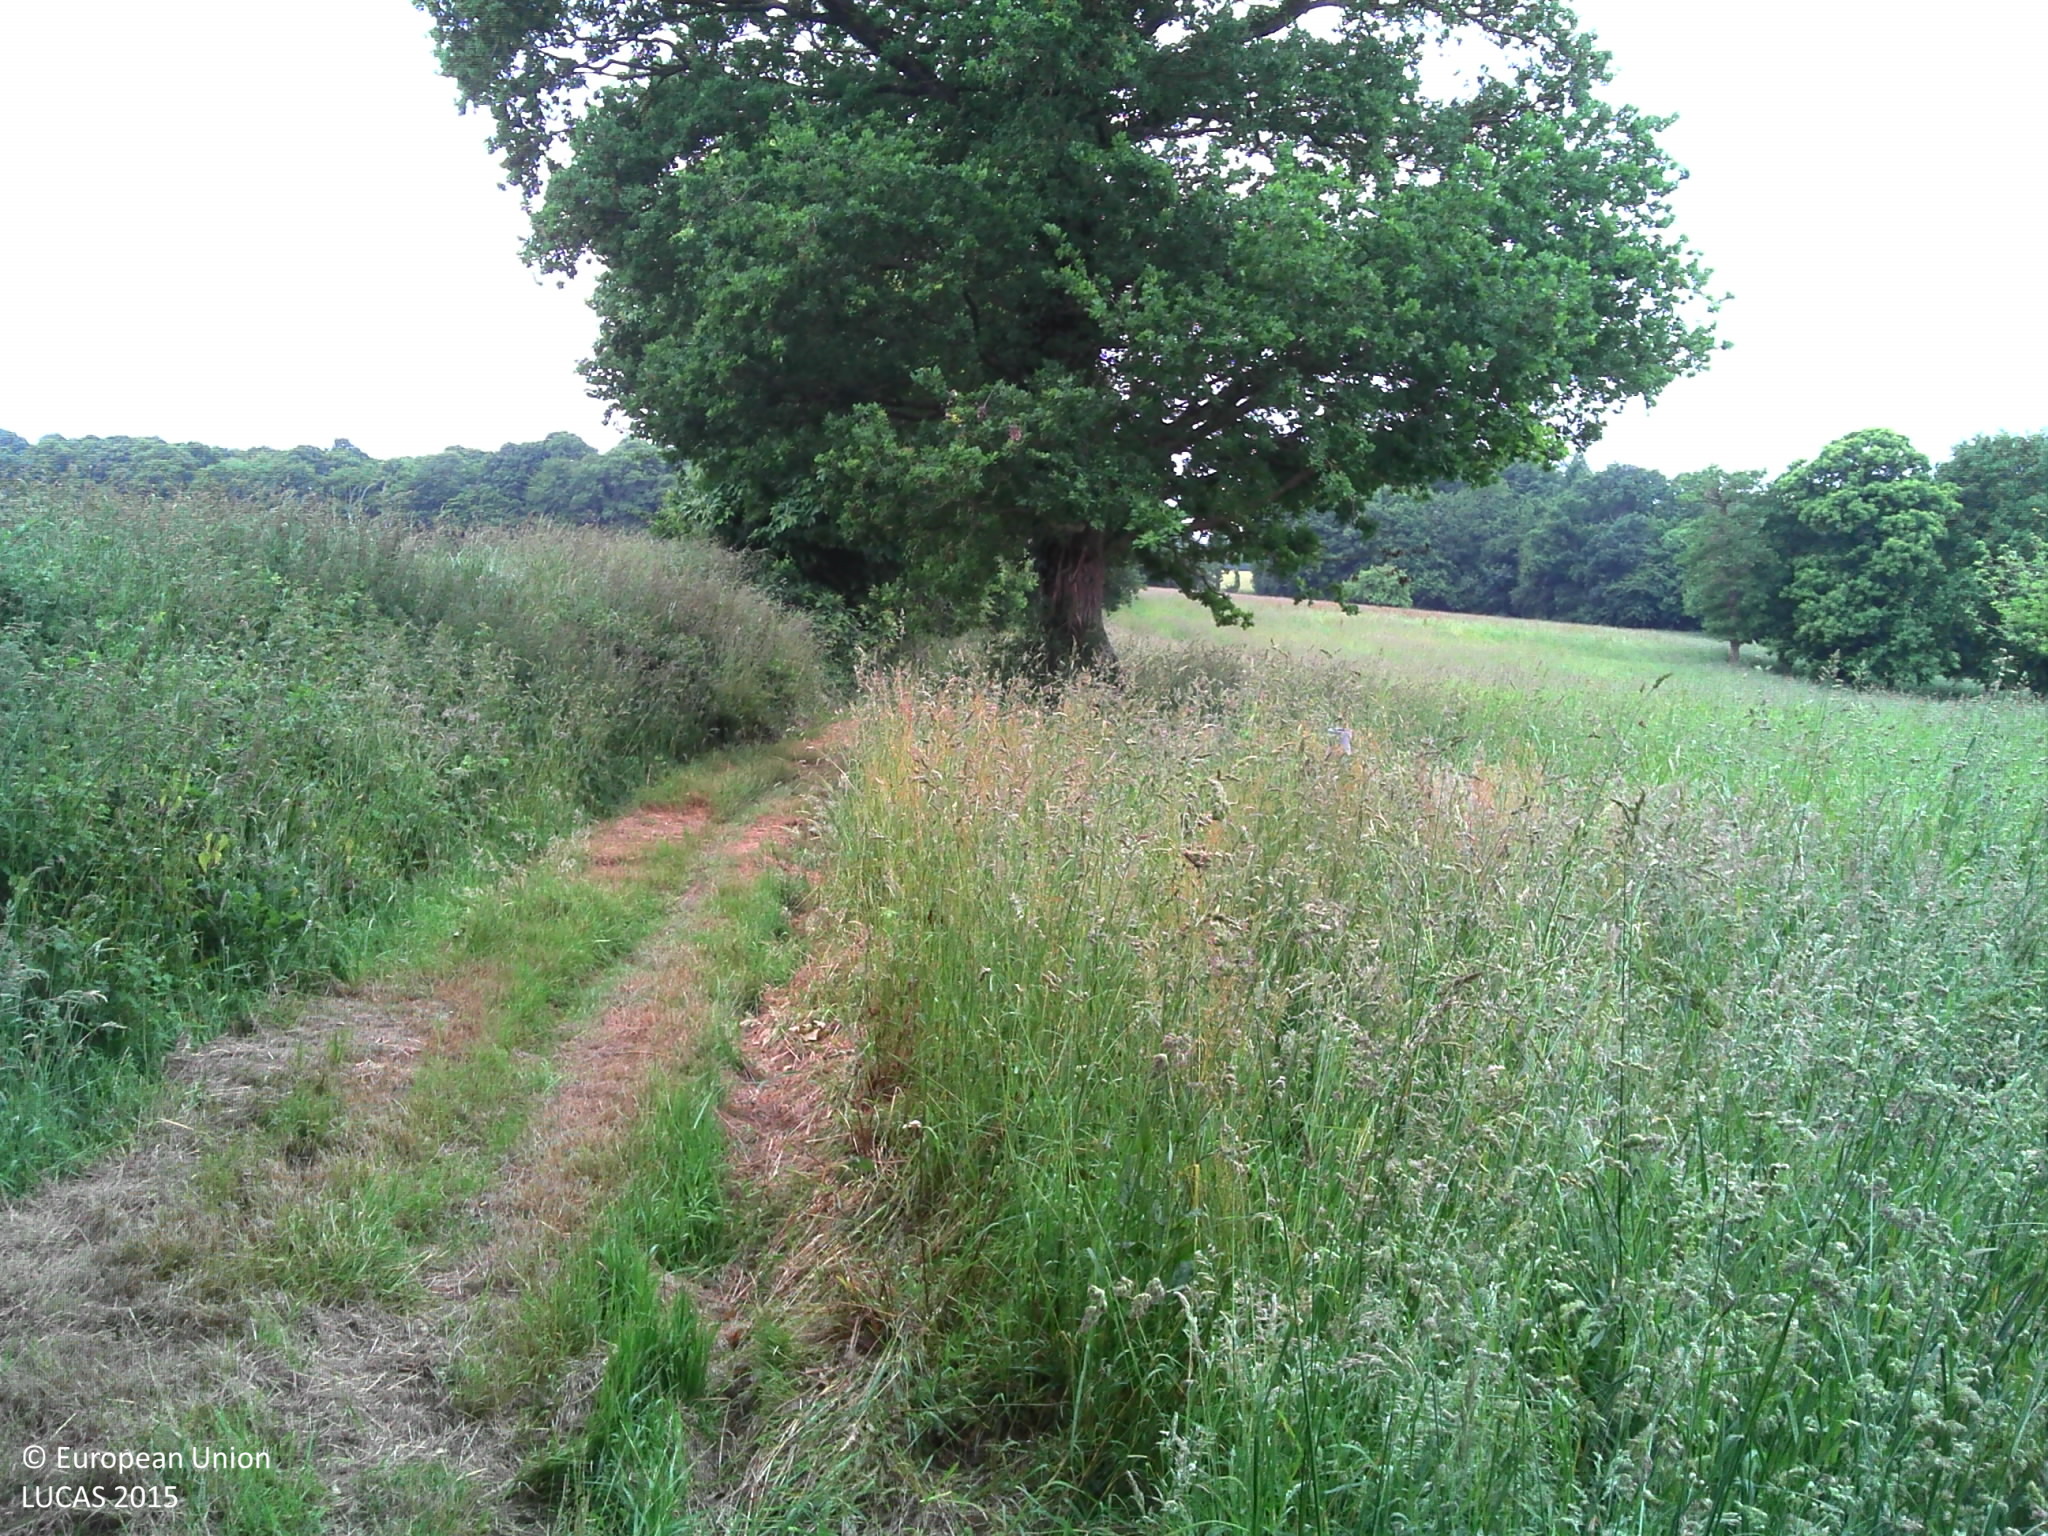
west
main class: Grassland
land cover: Grassland without tree/shrub cover
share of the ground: > 75 %
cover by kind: herbaceous plants 100 %
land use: Agriculture (excluding fallow land and kitchen gardens)
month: June
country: FR
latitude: 48.1148
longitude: -2.1301
